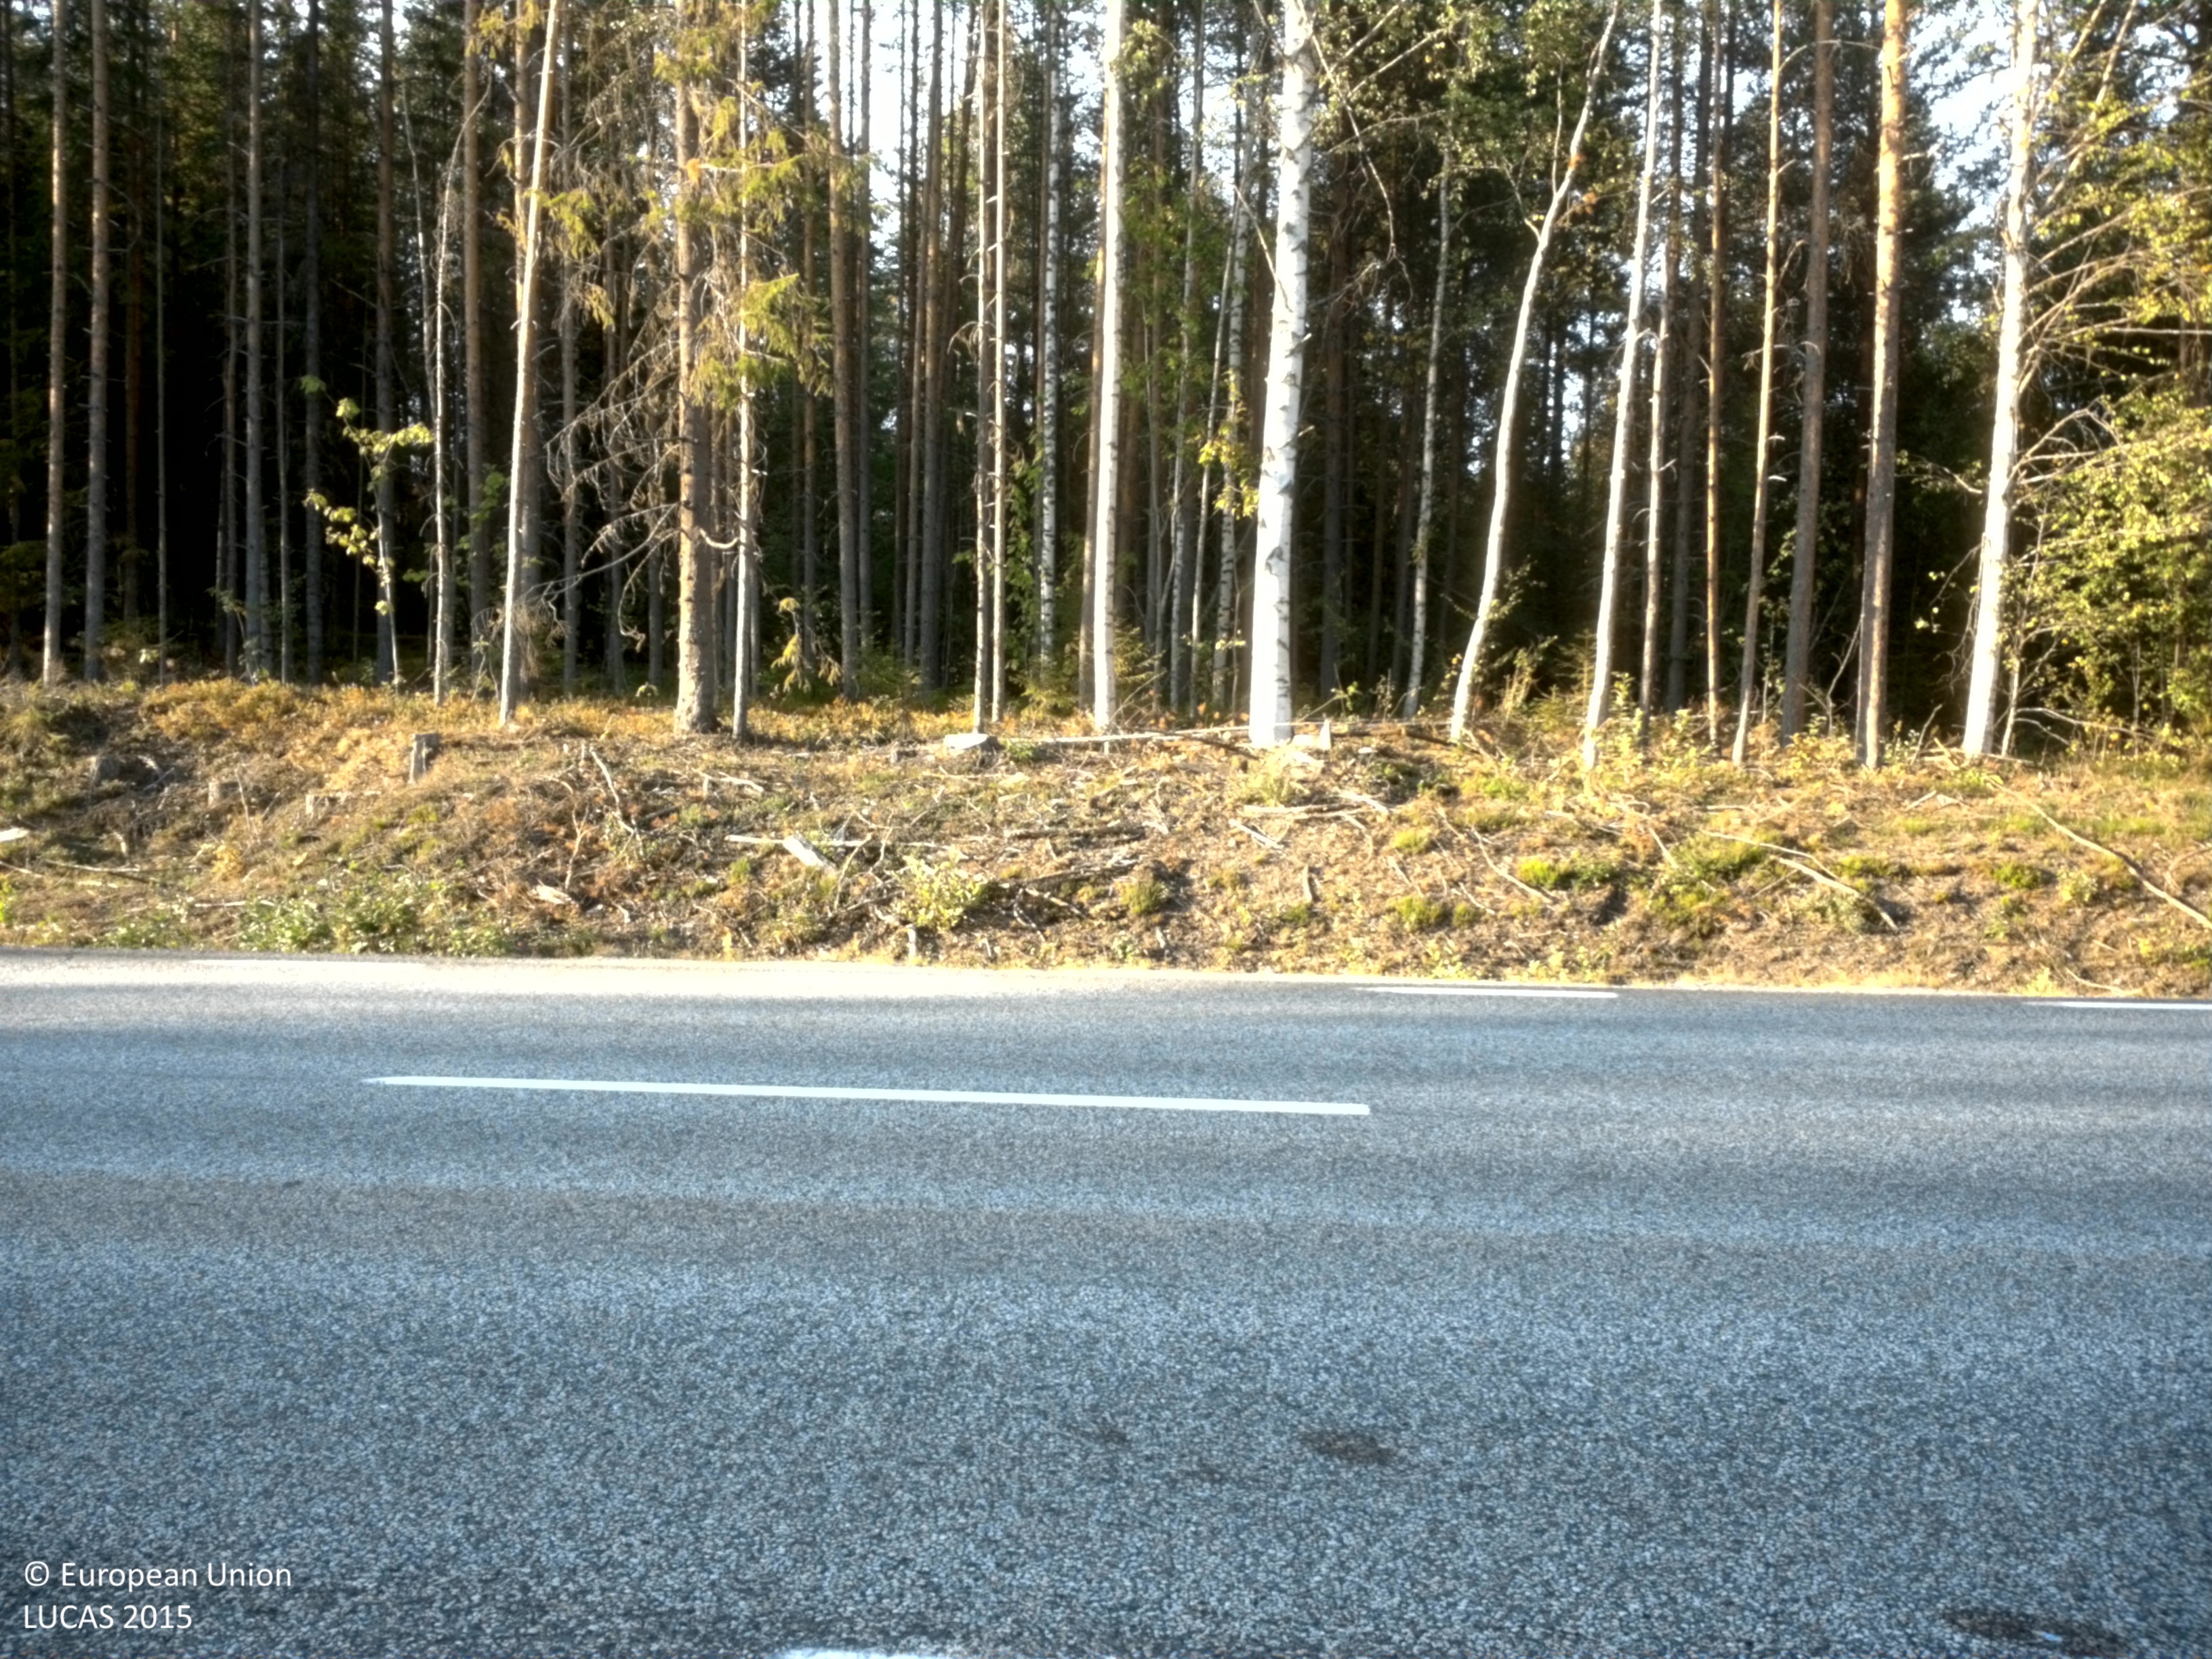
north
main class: Grassland
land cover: Grassland without tree/shrub cover
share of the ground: > 75 %
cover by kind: herbaceous plants 100 %
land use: Road transport
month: August
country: SE
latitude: 64.5139
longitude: 18.8632
